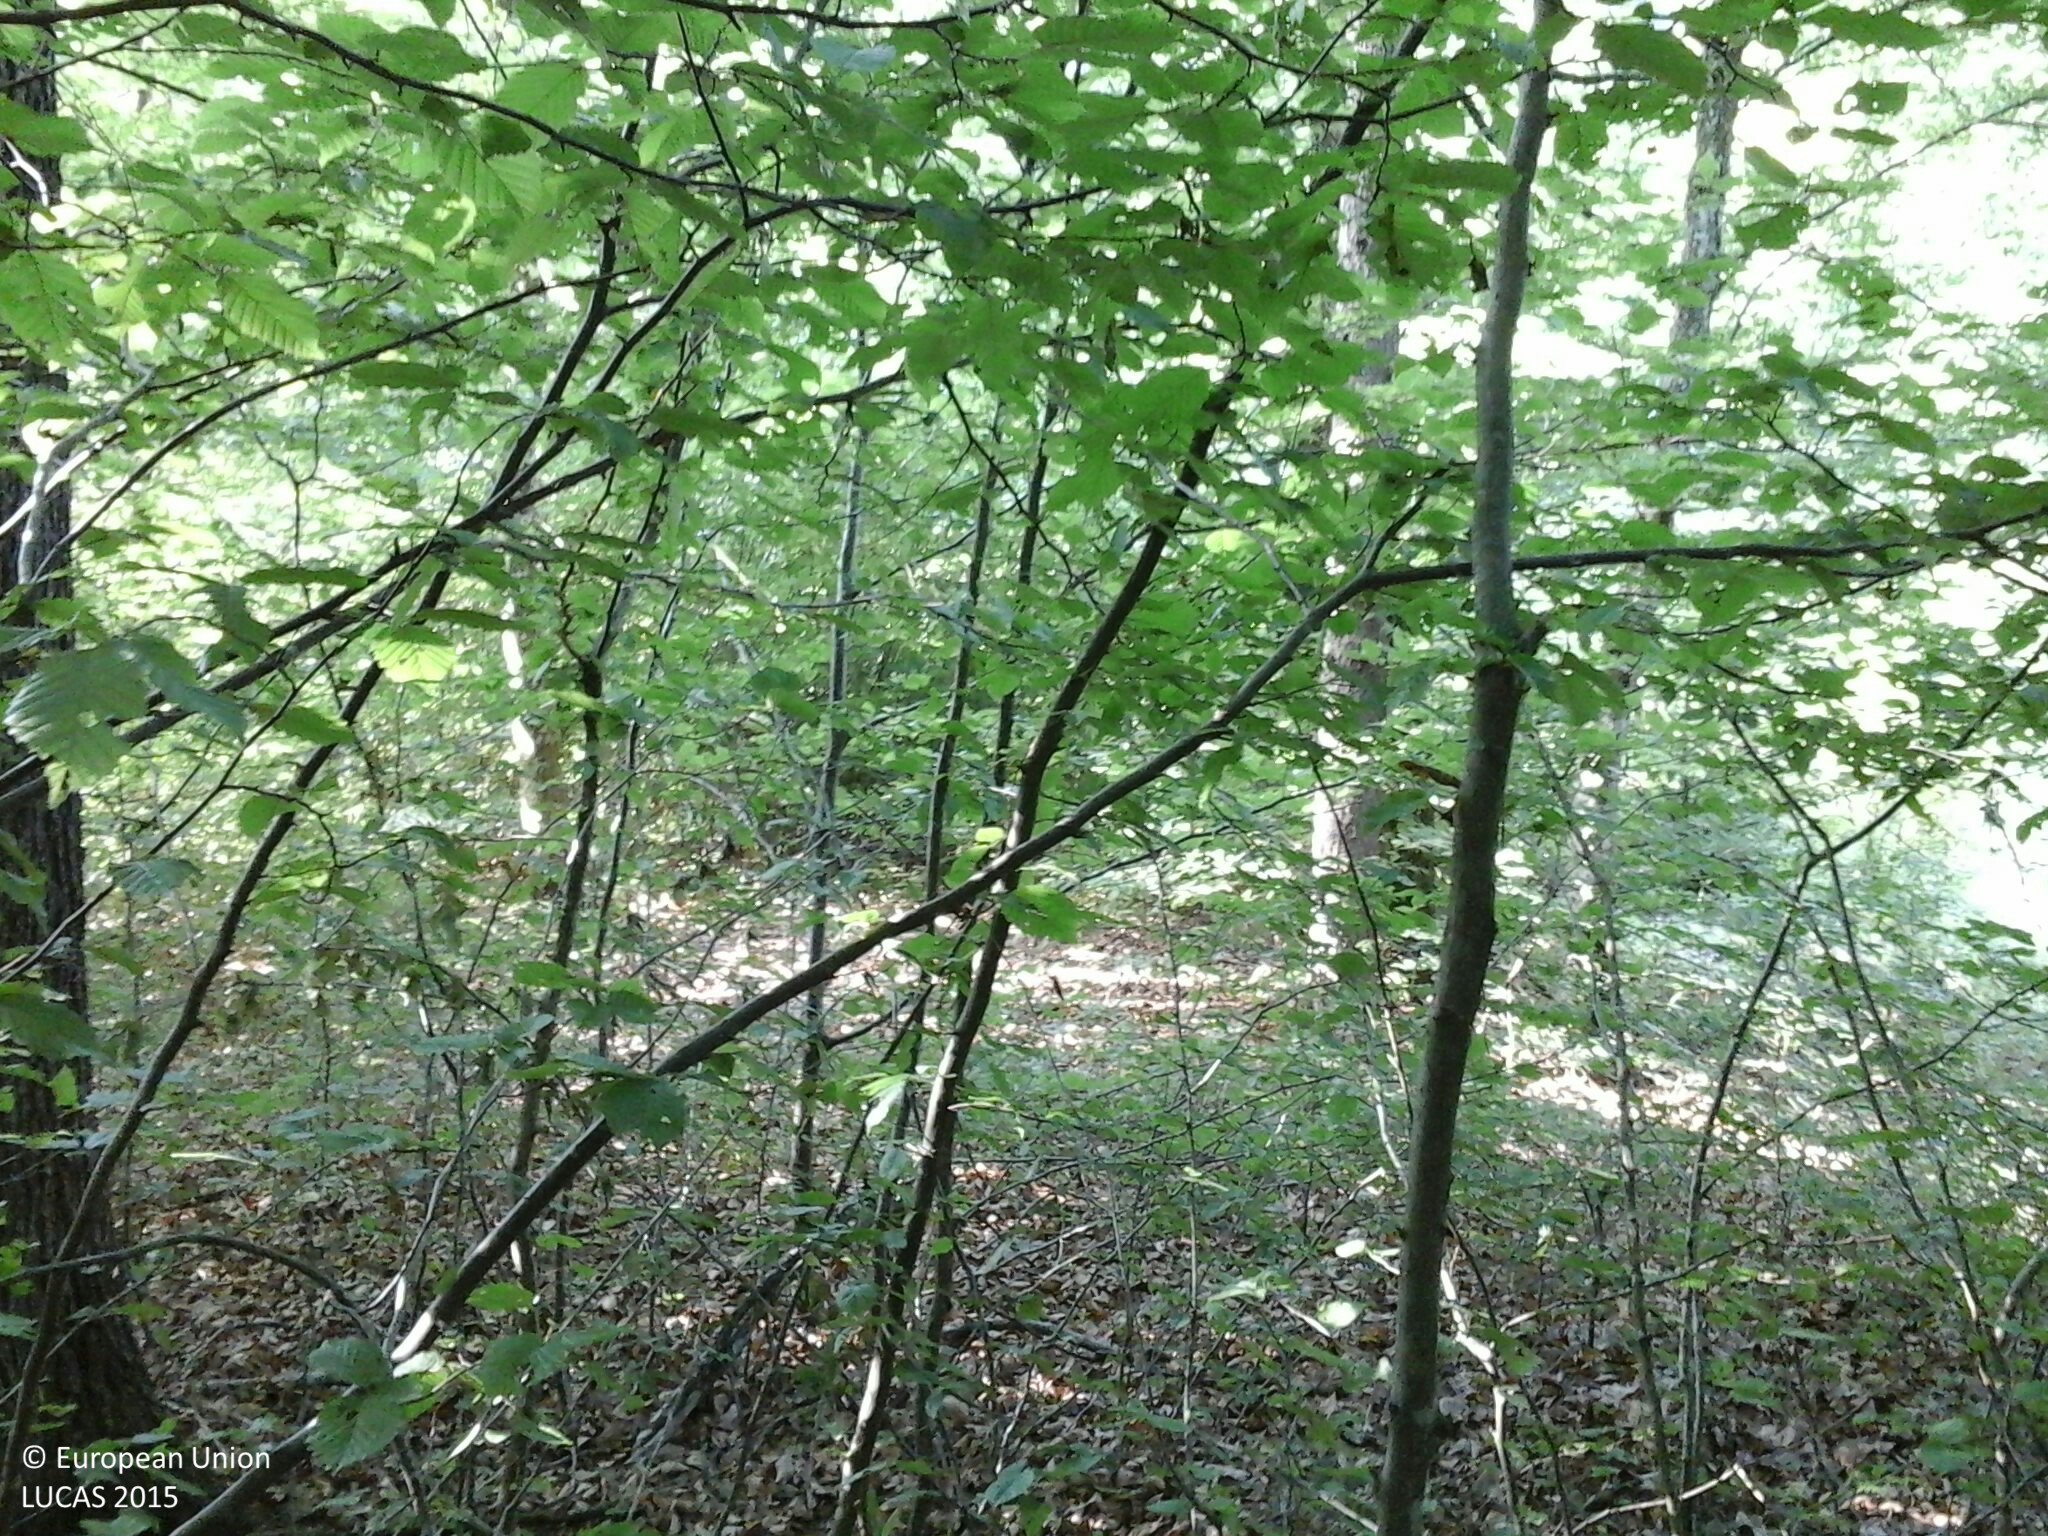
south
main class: Woodland
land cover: Broadleaved woodland
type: beech forest
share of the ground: > 75 %
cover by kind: broadleaved forest trees 95 %, shrubs 5 %
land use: Forestry
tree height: > 5 m
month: July
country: HU
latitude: 46.8603
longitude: 16.1530
